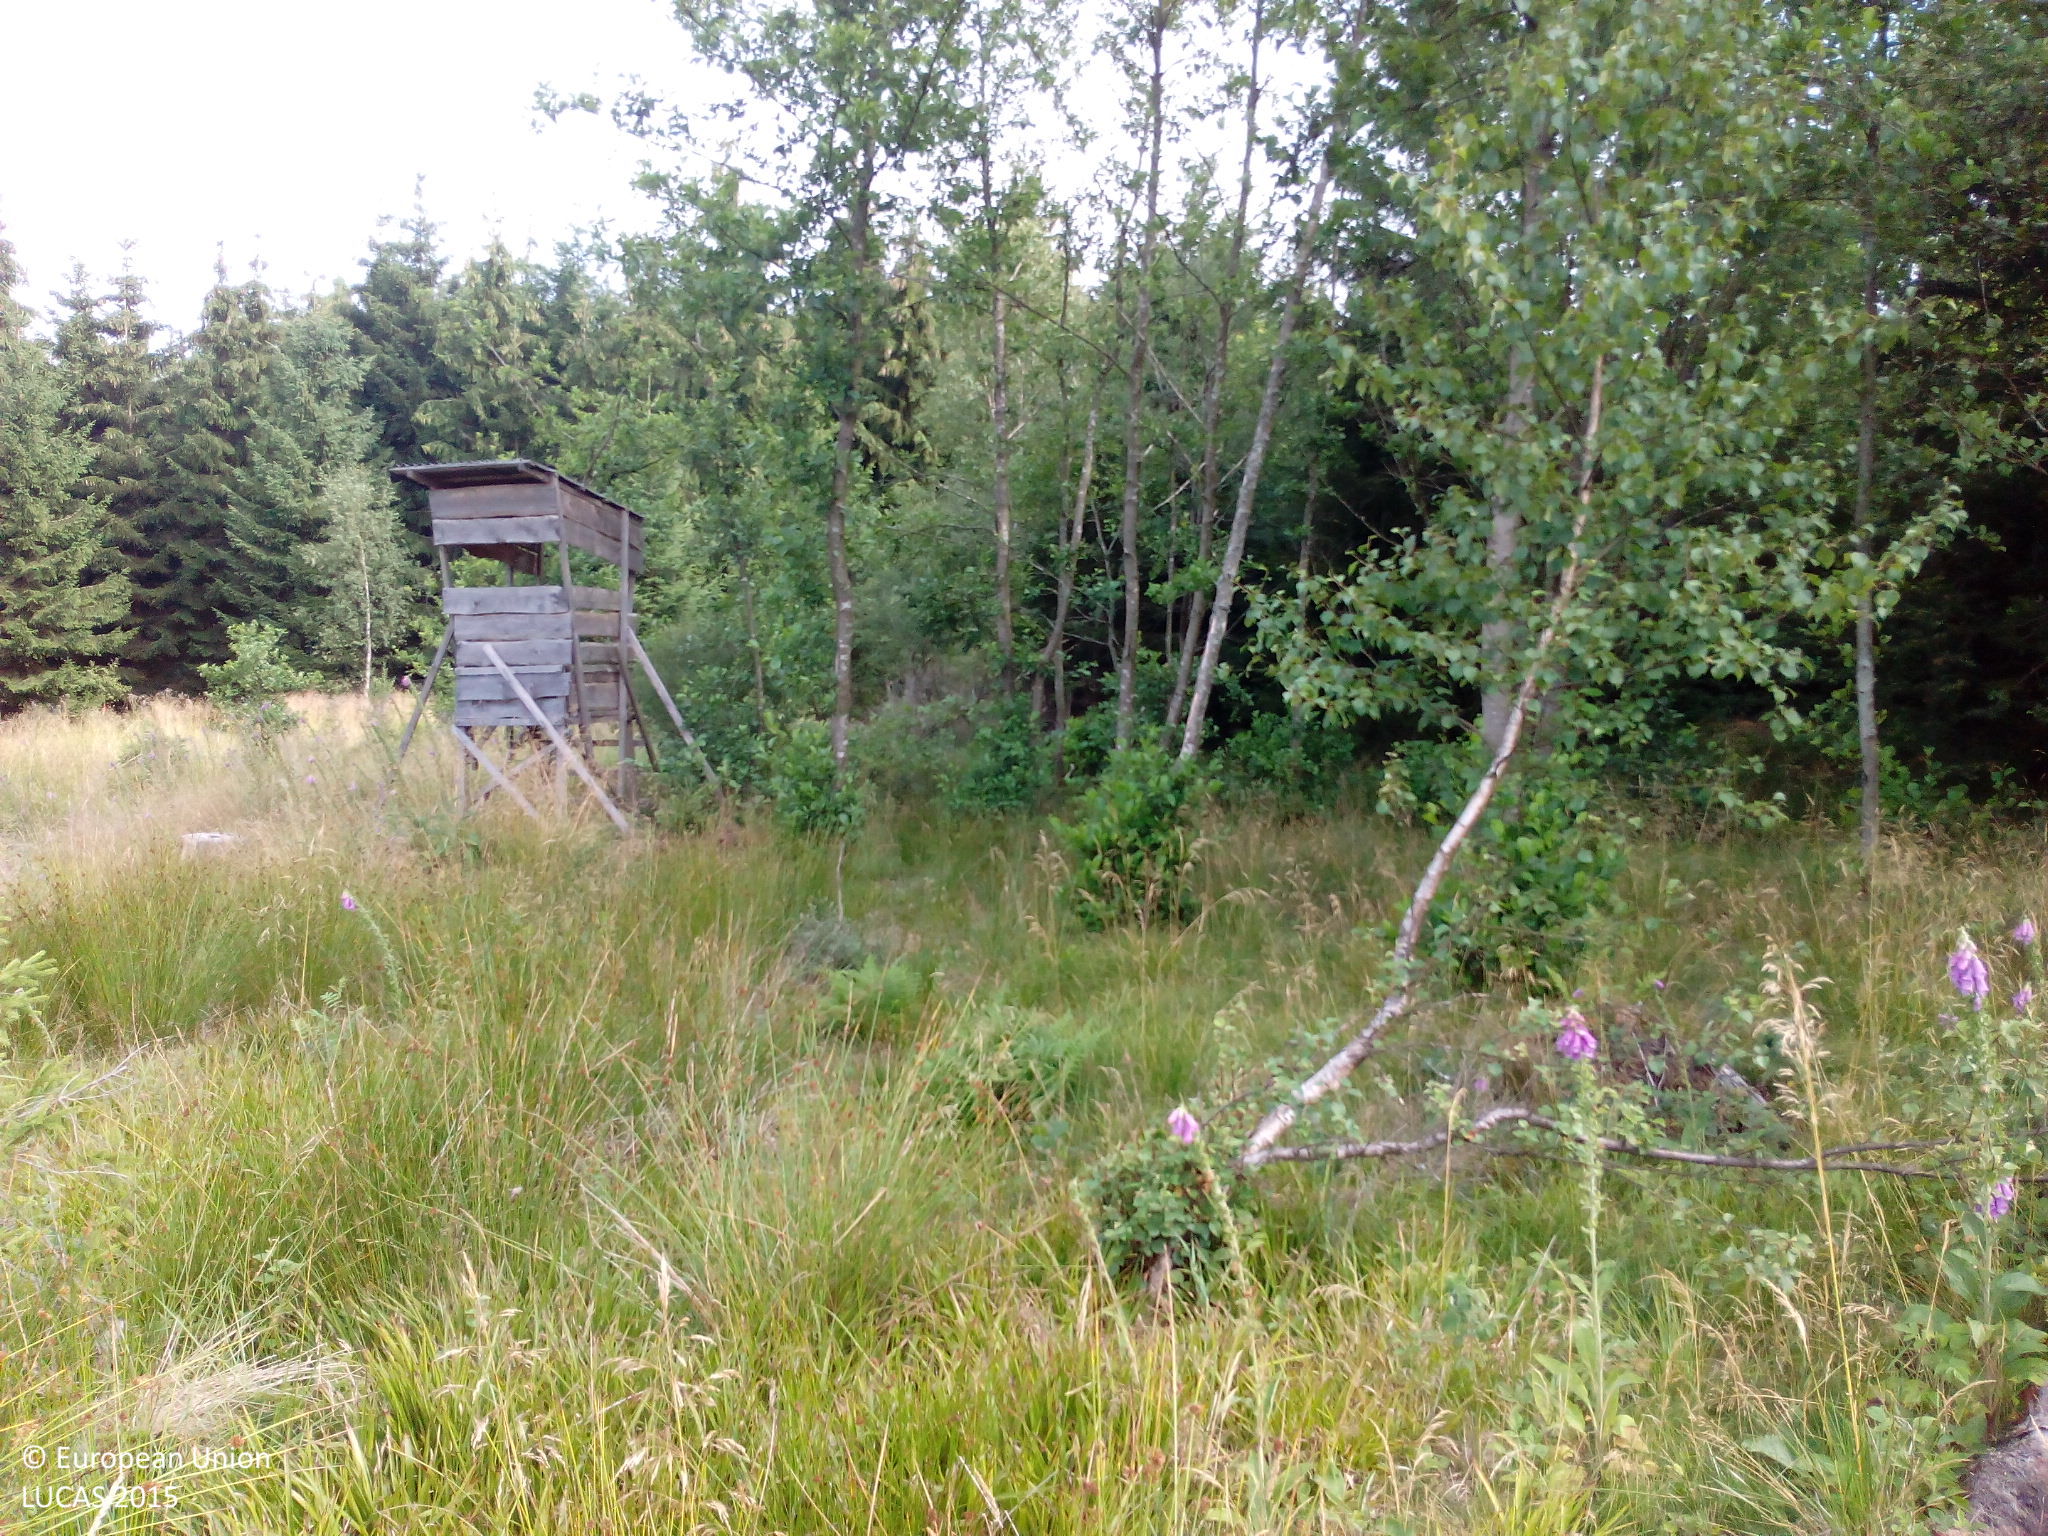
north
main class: Grassland
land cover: Spontaneously vegetated surfaces
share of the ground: > 75 %
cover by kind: herbaceous plants 80 %, shrubs 5 %, unconsolidated bare surface 5 %
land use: Forestry
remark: Clear cut
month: July
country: DE
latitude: 49.9070
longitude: 7.5915
